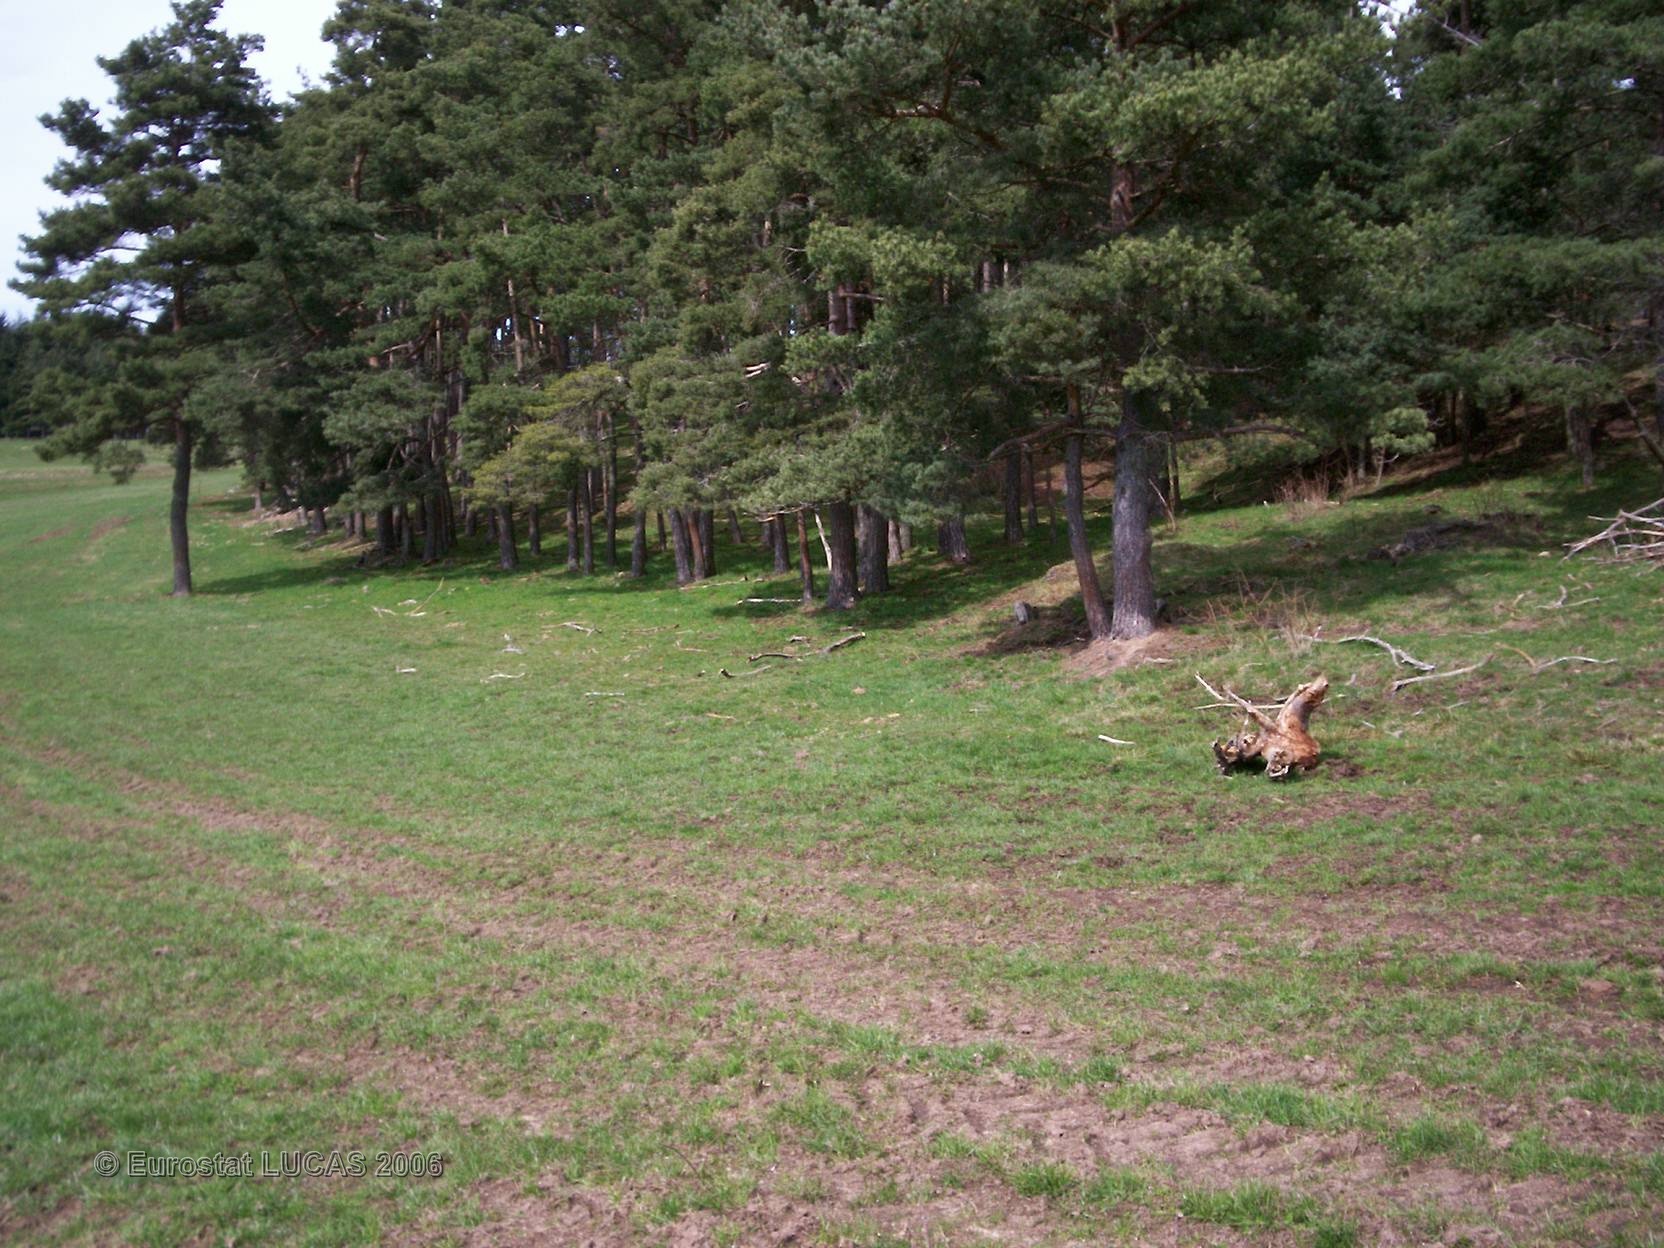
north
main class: Grassland
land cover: Grassland without tree/shrub cover
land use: Agriculture (excluding fallow land and kitchen gardens)
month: April
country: FR
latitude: 44.8206
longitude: 3.2883
